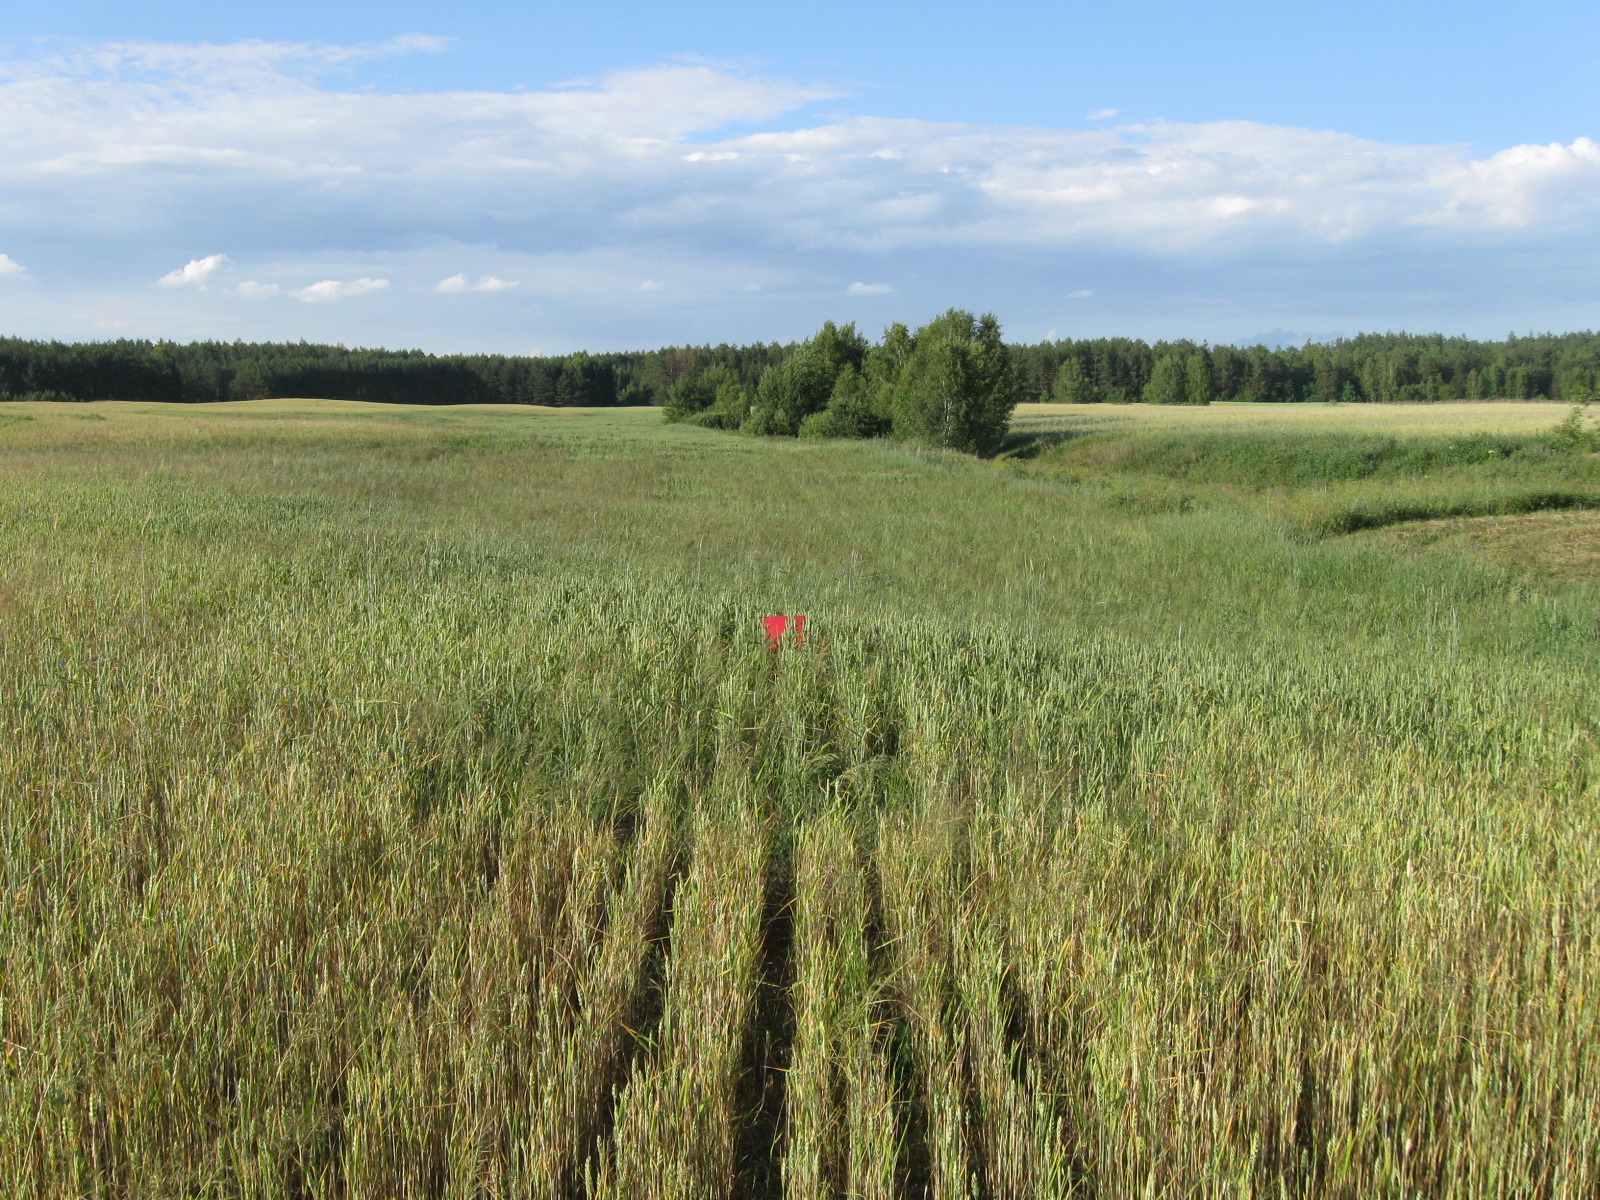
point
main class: Cropland
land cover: Common wheat
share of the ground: > 75 %
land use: Agriculture (excluding fallow land and kitchen gardens)
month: June
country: LT
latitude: 54.2372
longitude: 24.2285
